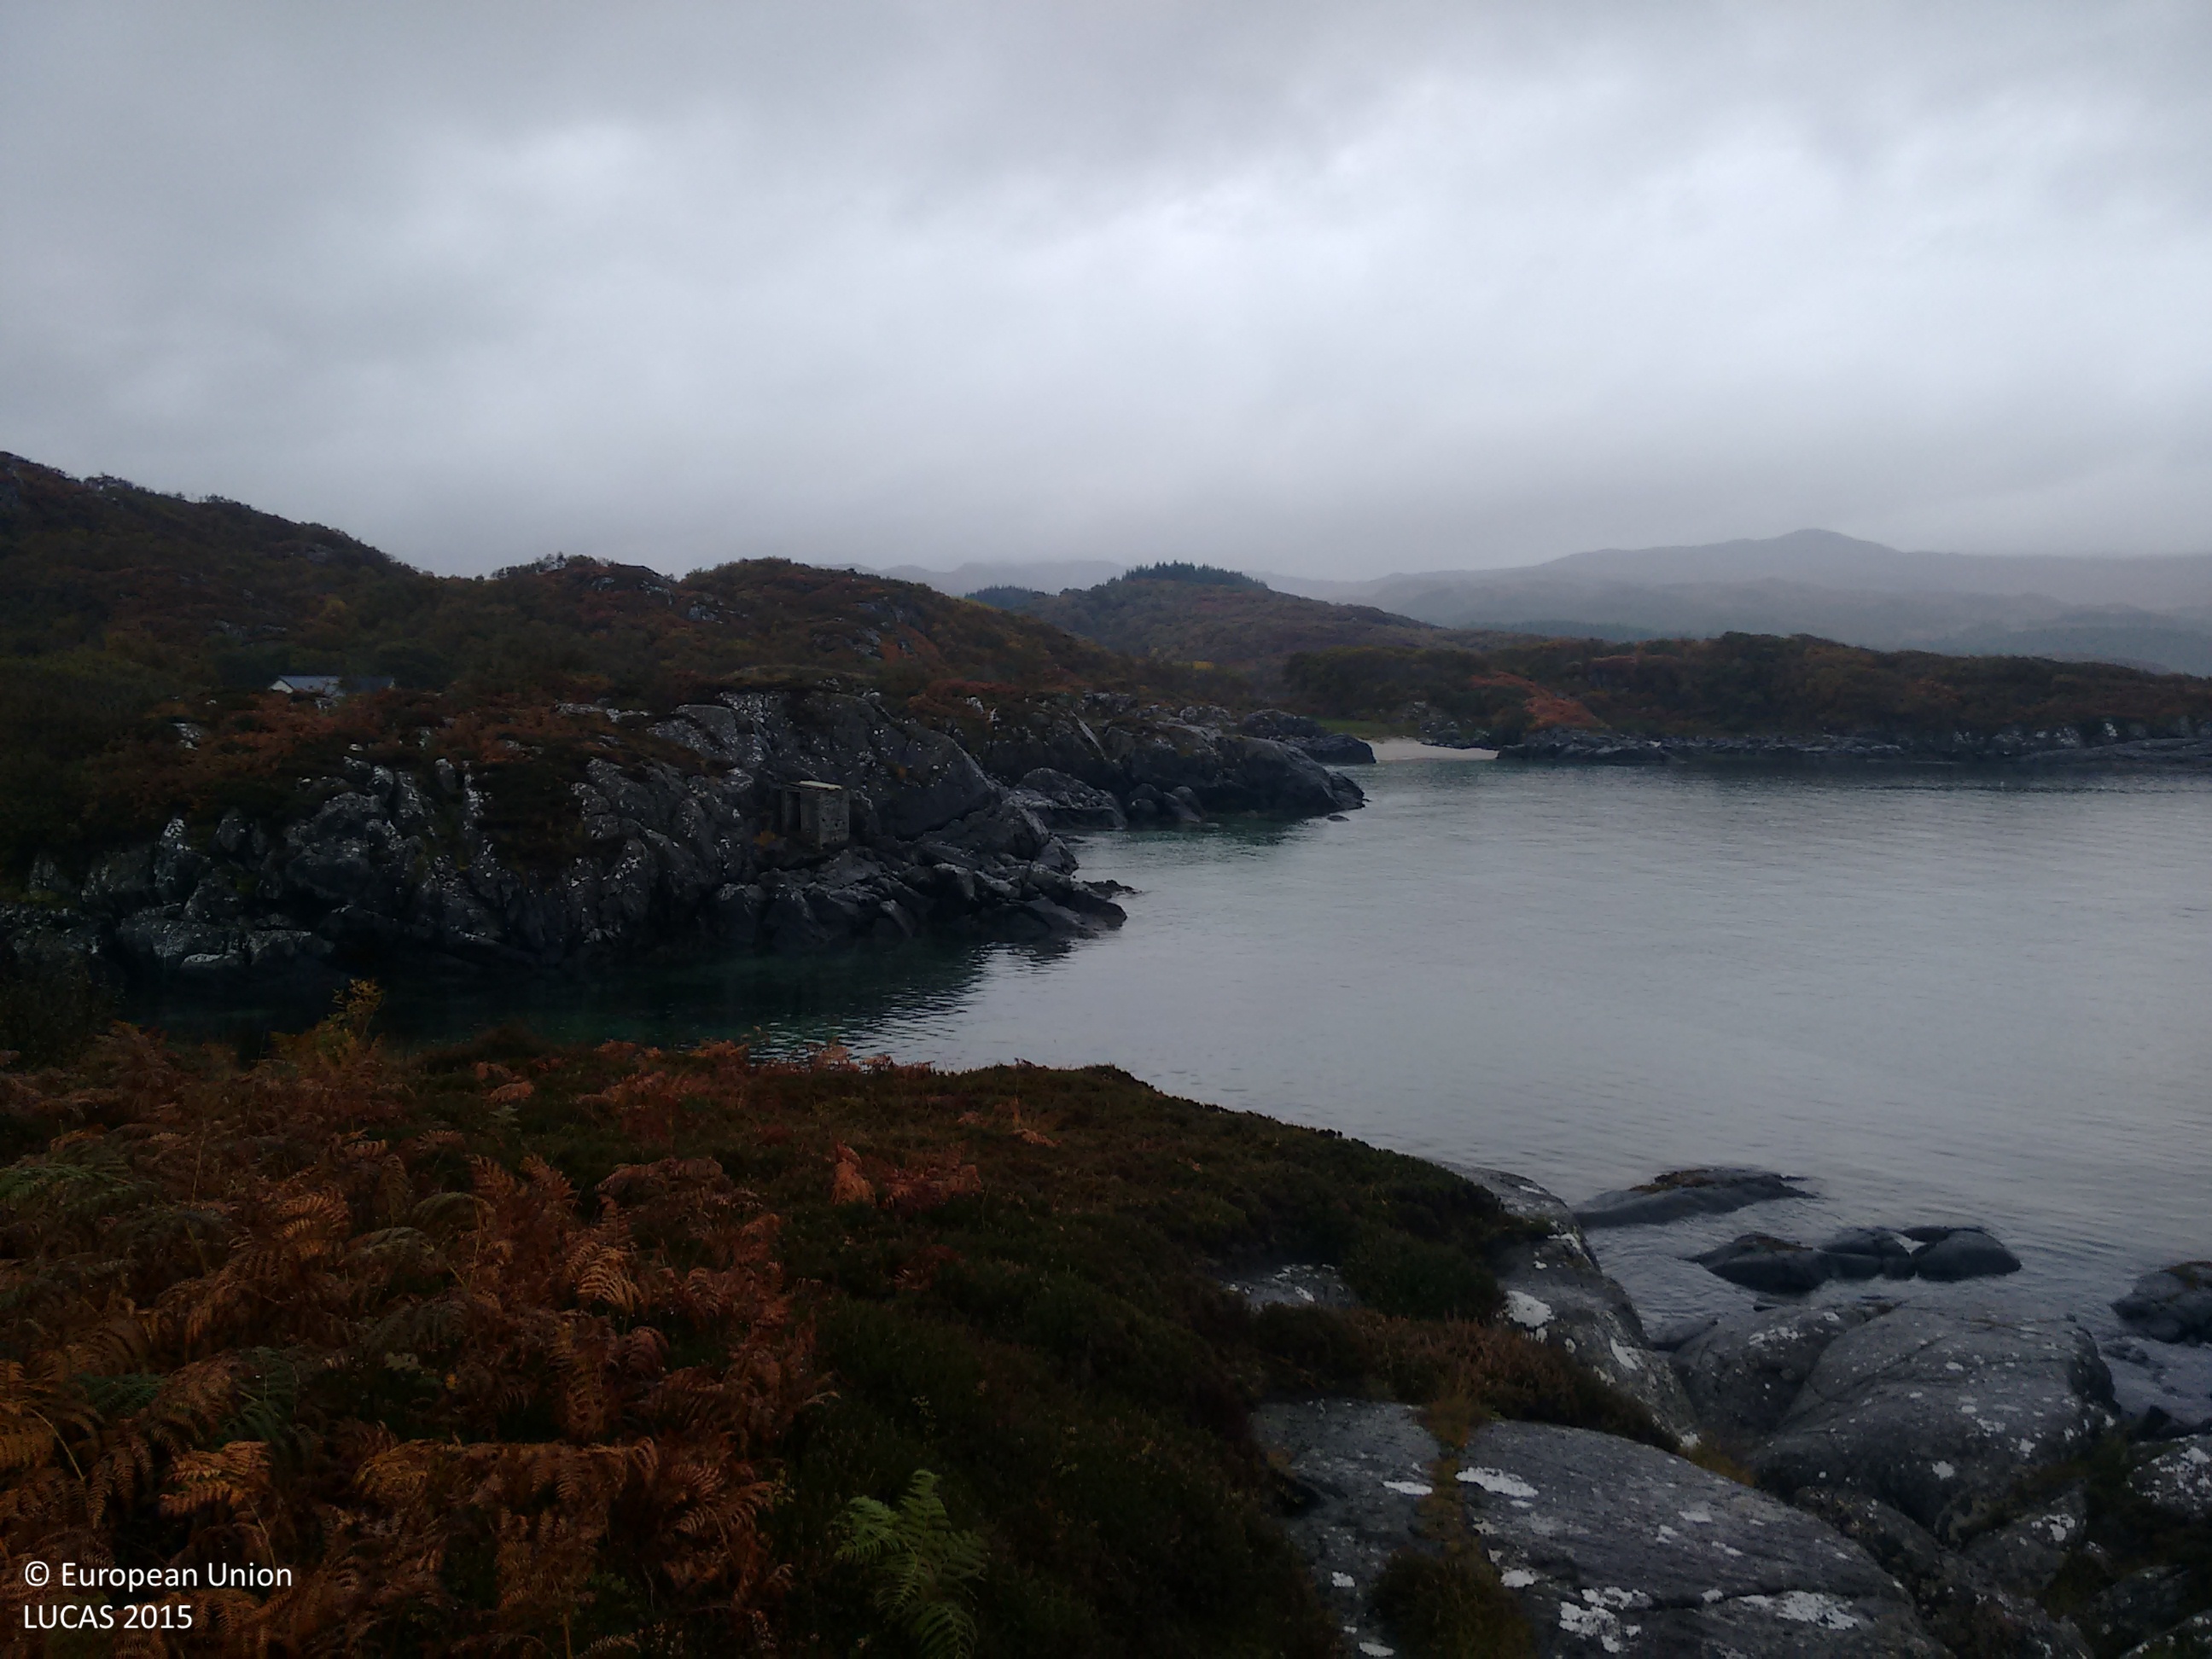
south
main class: Shrubland
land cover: Shrubland without tree cover
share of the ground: > 75 %
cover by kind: shrubs 50 %, herbaceous plants 30 %, consolidated bare surface 20 %
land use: Amenities, museums, leisure
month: October
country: GB
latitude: 56.7690
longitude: -5.8851
